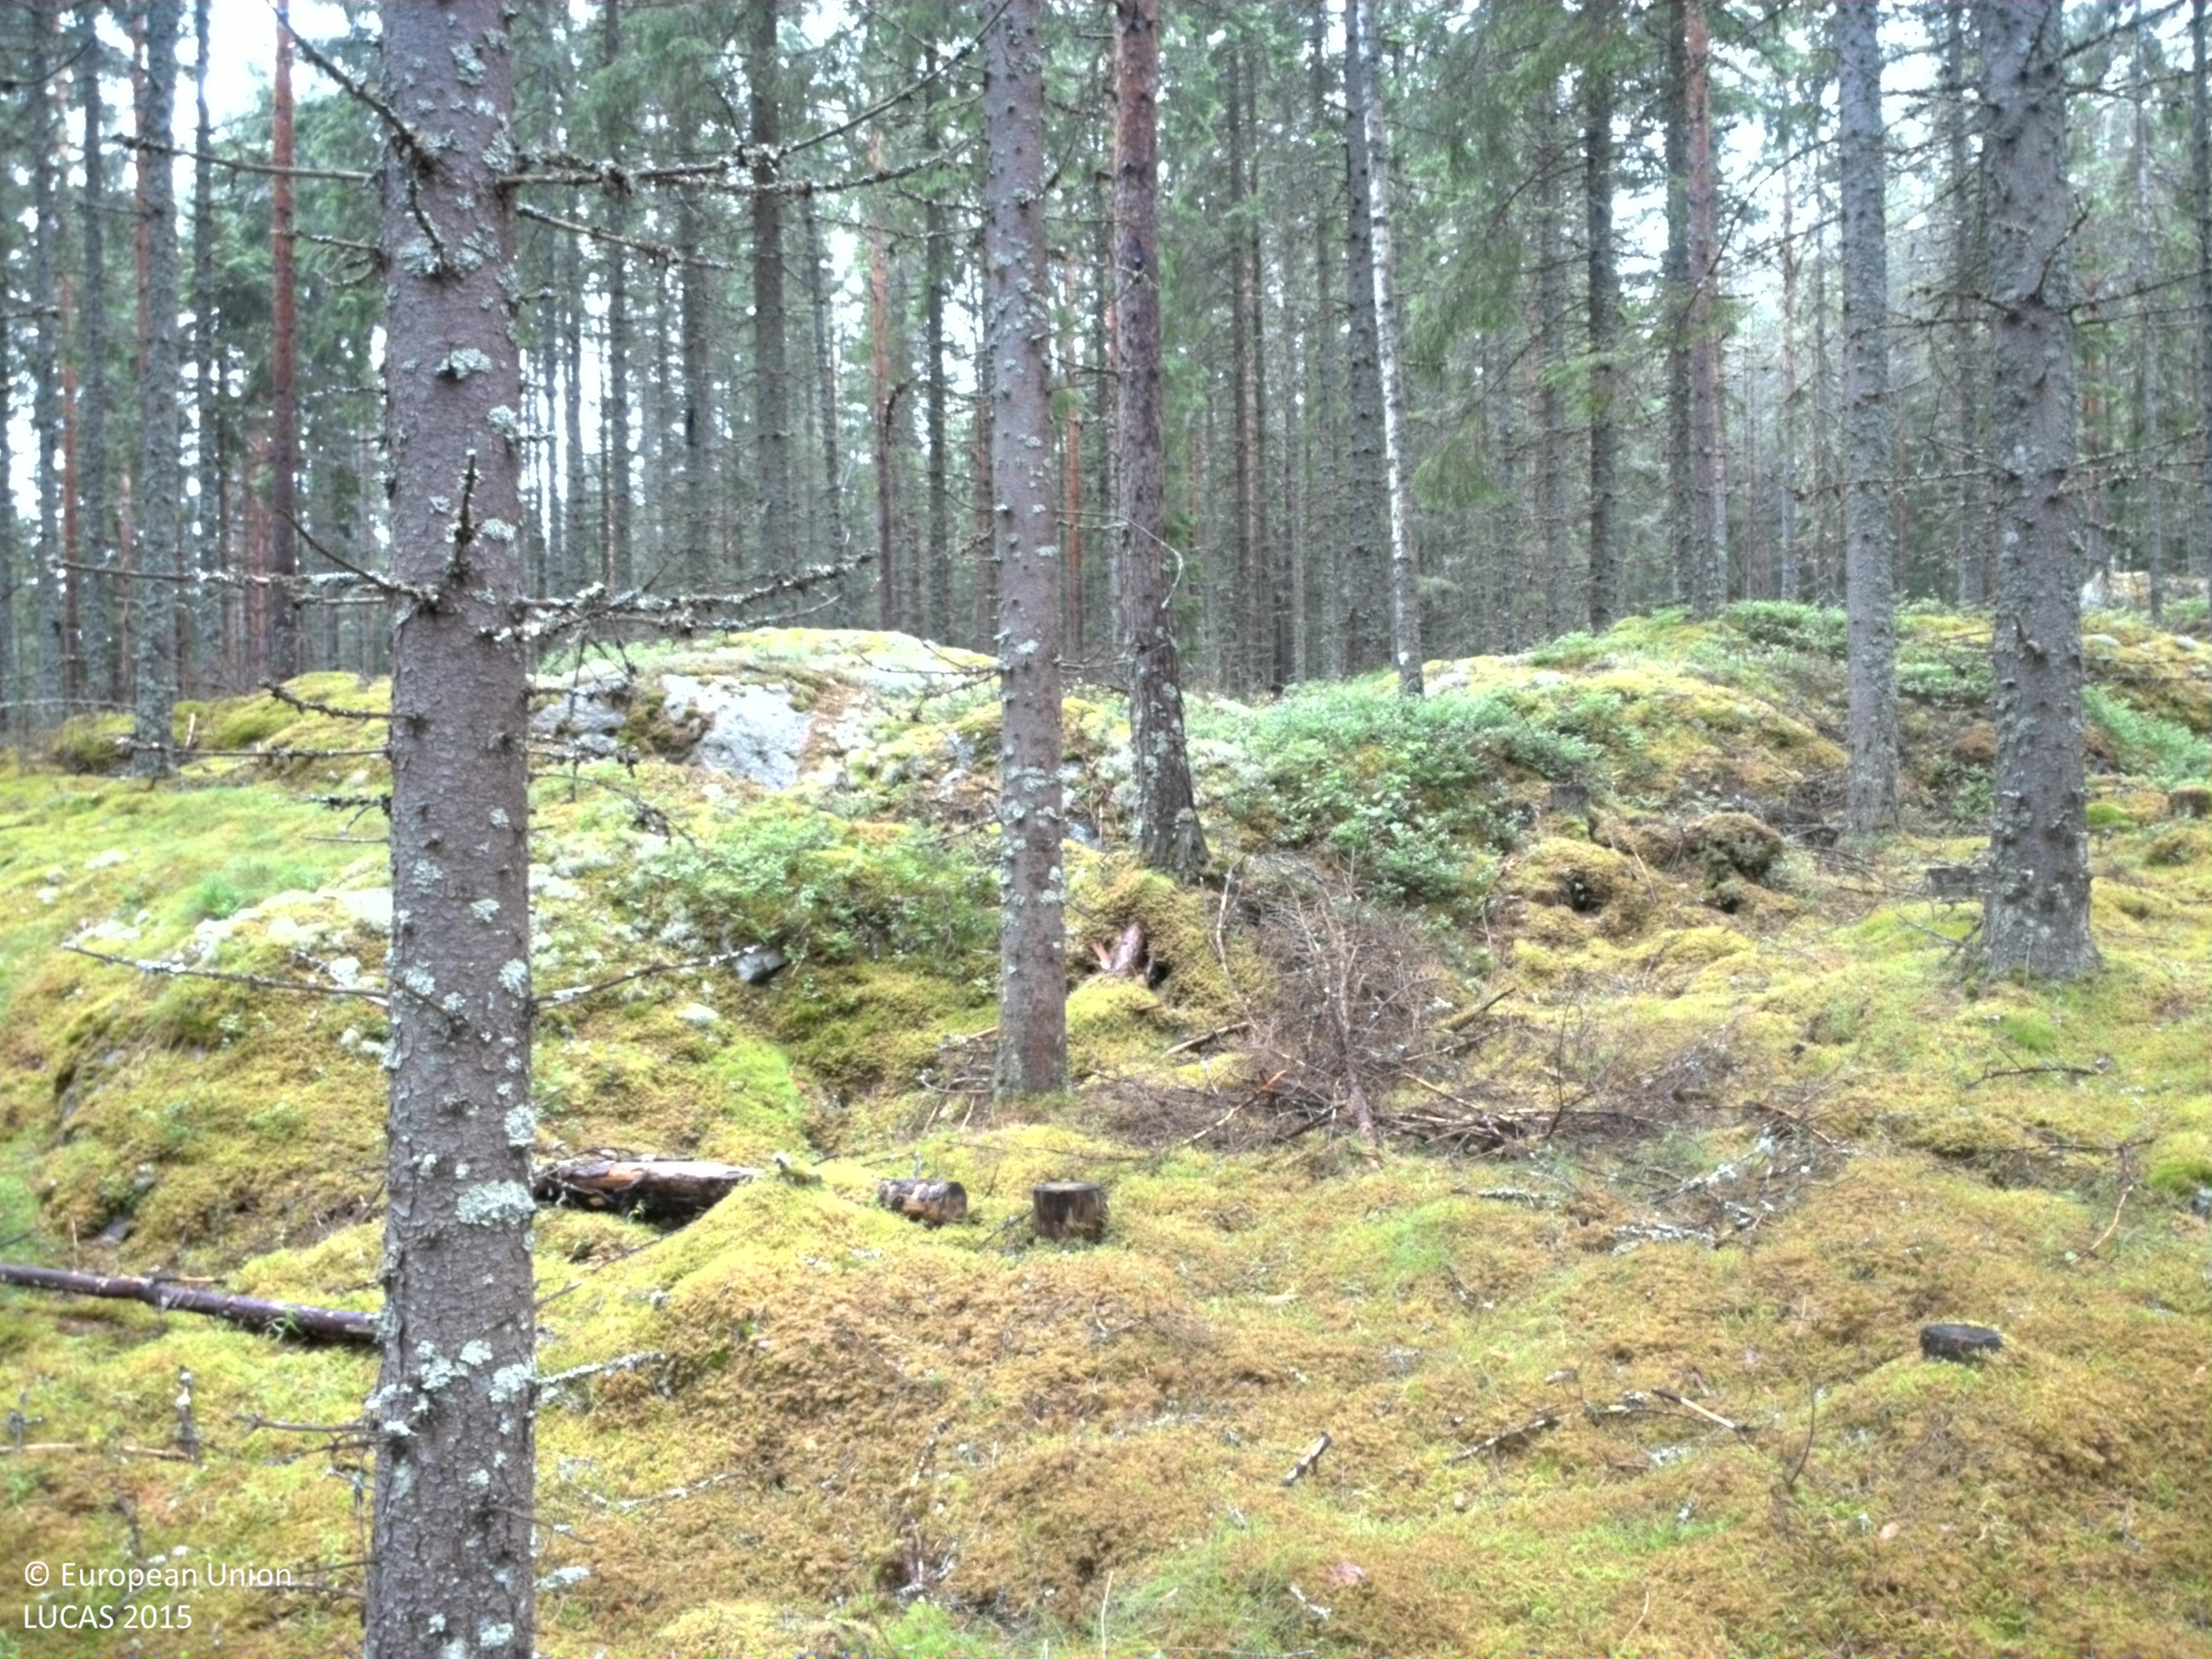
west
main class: Woodland
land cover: Spruce dominated coniferous woodland
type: boreal forest
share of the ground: 50 - 75 %
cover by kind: coniferous forest trees 65 %, lichens and mosses 20 %, shrubs 10 %, broadleaved forest trees 5 %
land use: Forestry
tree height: > 5 m
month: July
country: SE
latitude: 59.5019
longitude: 11.8852
